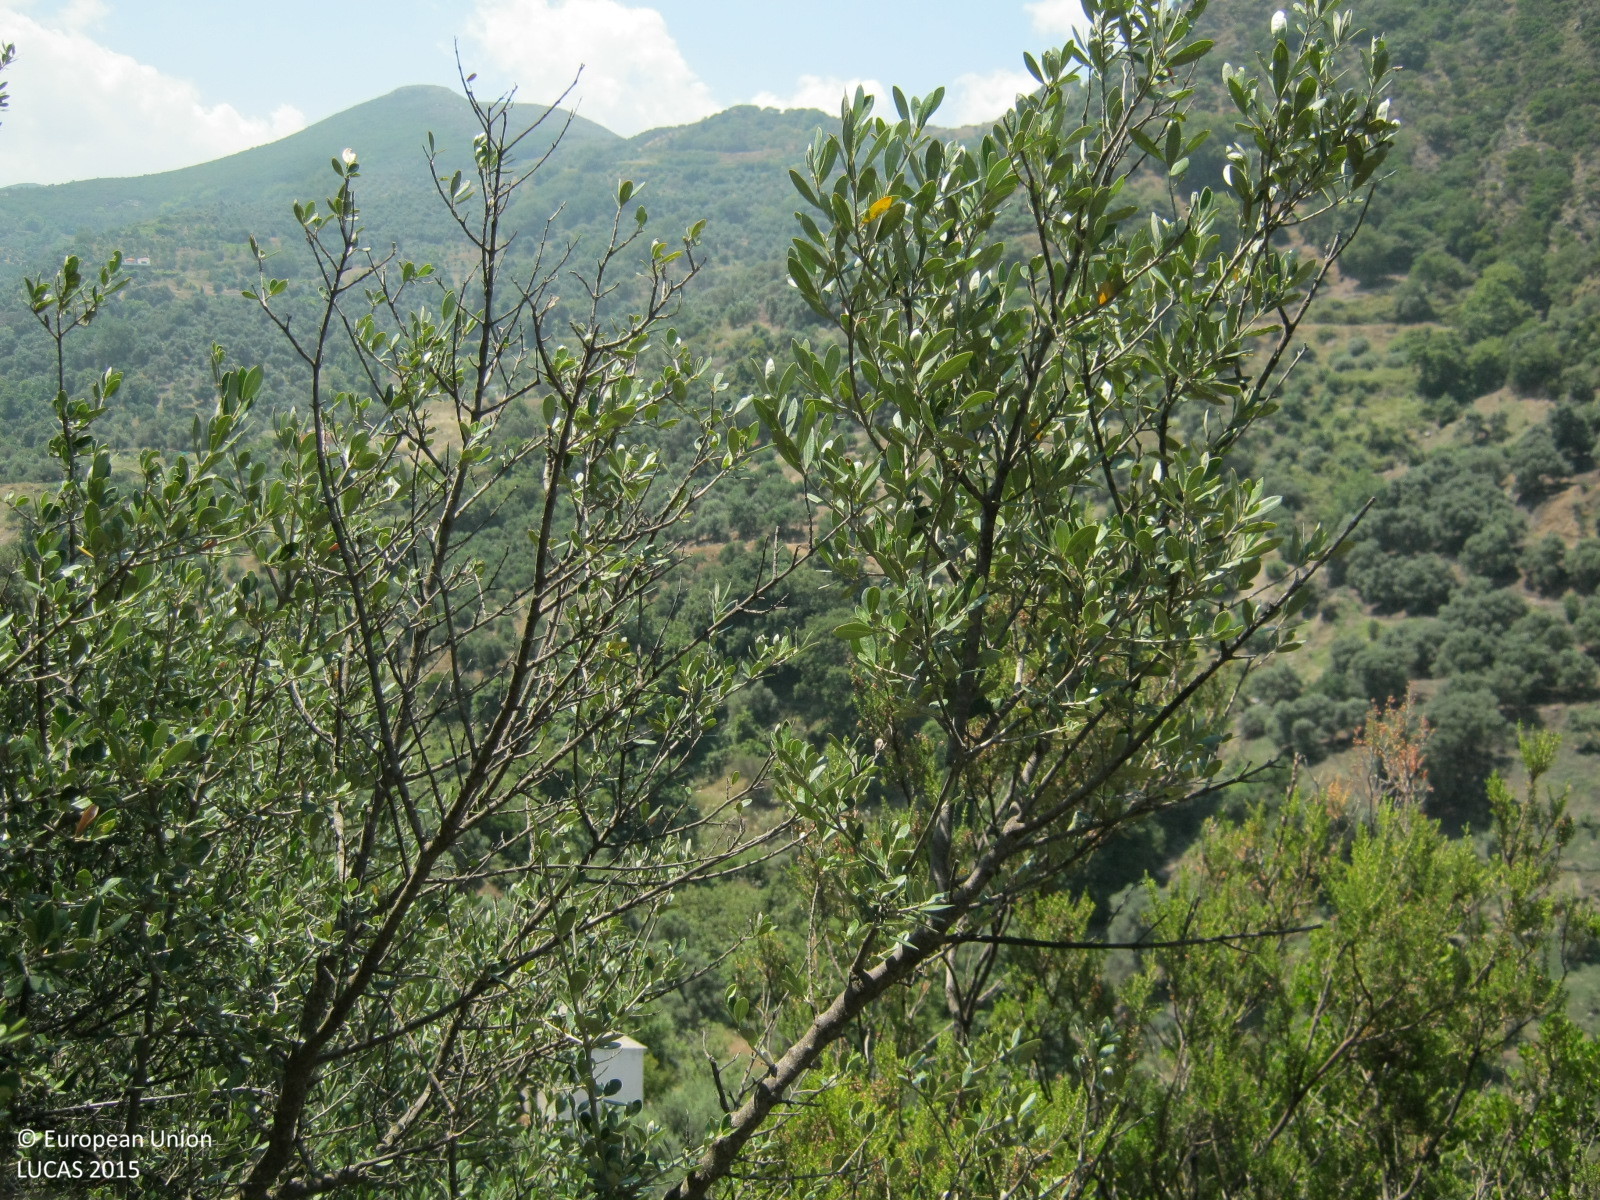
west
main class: Woodland
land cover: Broadleaved woodland
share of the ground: > 75 %
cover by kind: broadleaved forest trees 80 %, unconsolidated bare surface 10 %, shrubs 5 %, herbaceous plants 5 %
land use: Semi-natural and natural areas not in use
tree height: < 5 m
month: July
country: GR
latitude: 35.4331
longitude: 23.7847
